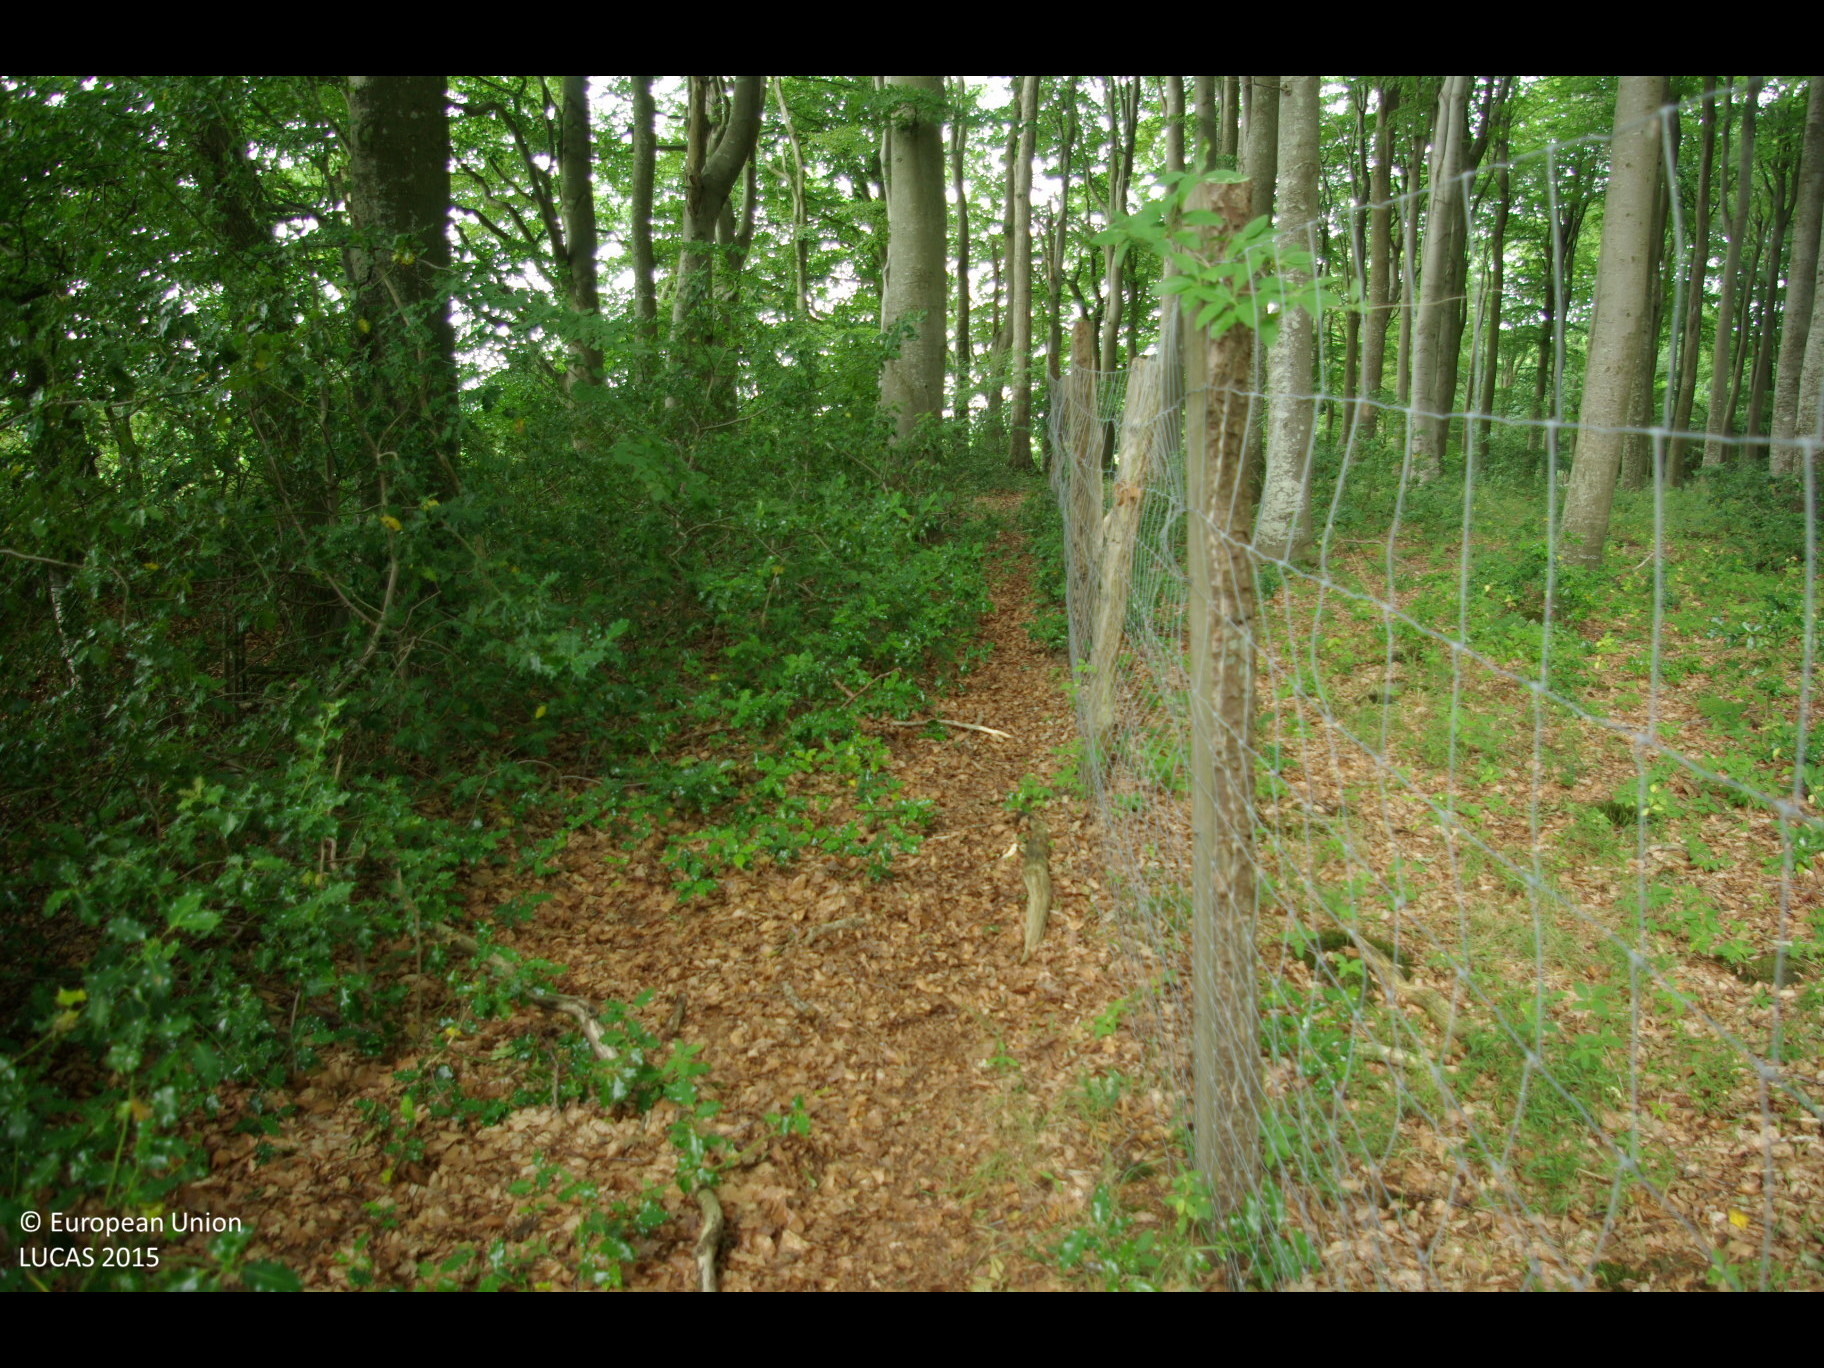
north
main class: Woodland
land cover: Broadleaved woodland
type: beech forest
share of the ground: > 75 %
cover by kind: broadleaved forest trees 90 %, herbaceous plants 10 %
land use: Semi-natural and natural areas not in use
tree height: > 5 m
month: July
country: DE
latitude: 54.6959
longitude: 9.9535
